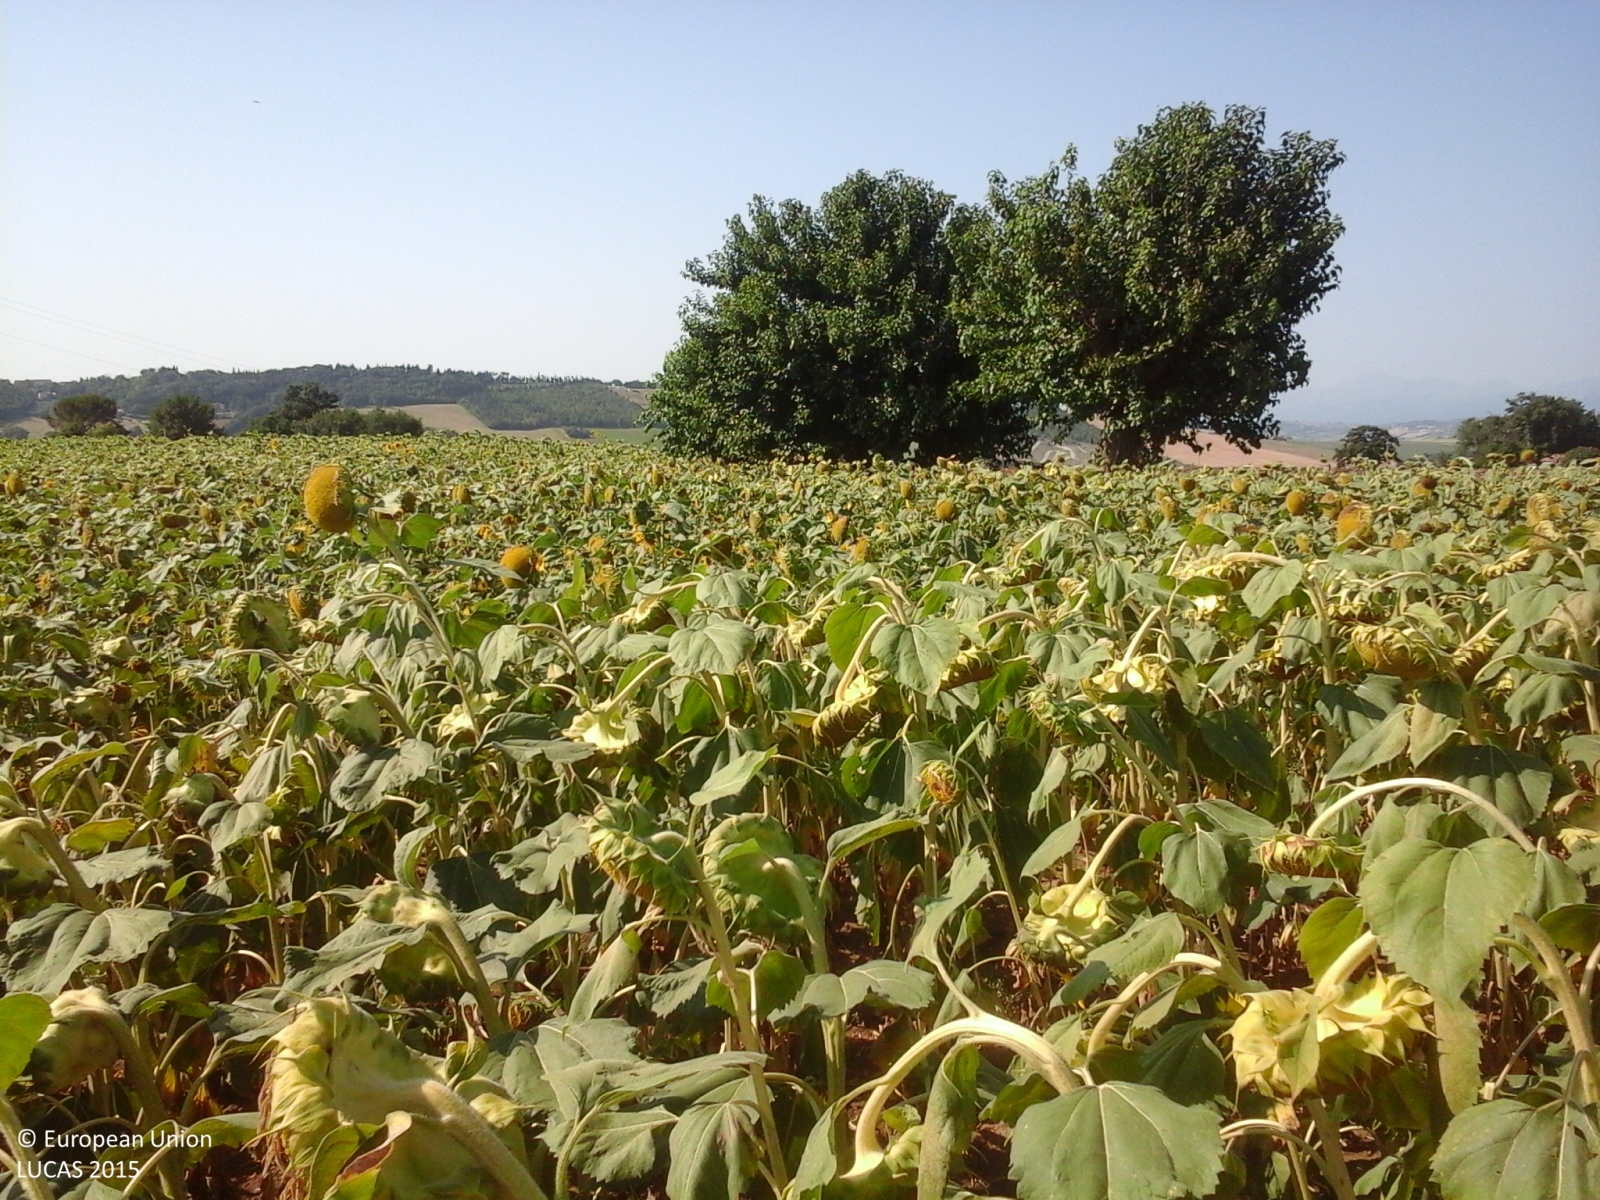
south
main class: Cropland
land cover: Sunflower
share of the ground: > 75 %
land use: Agriculture (excluding fallow land and kitchen gardens)
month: July
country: IT
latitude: 43.2646
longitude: 13.4283
